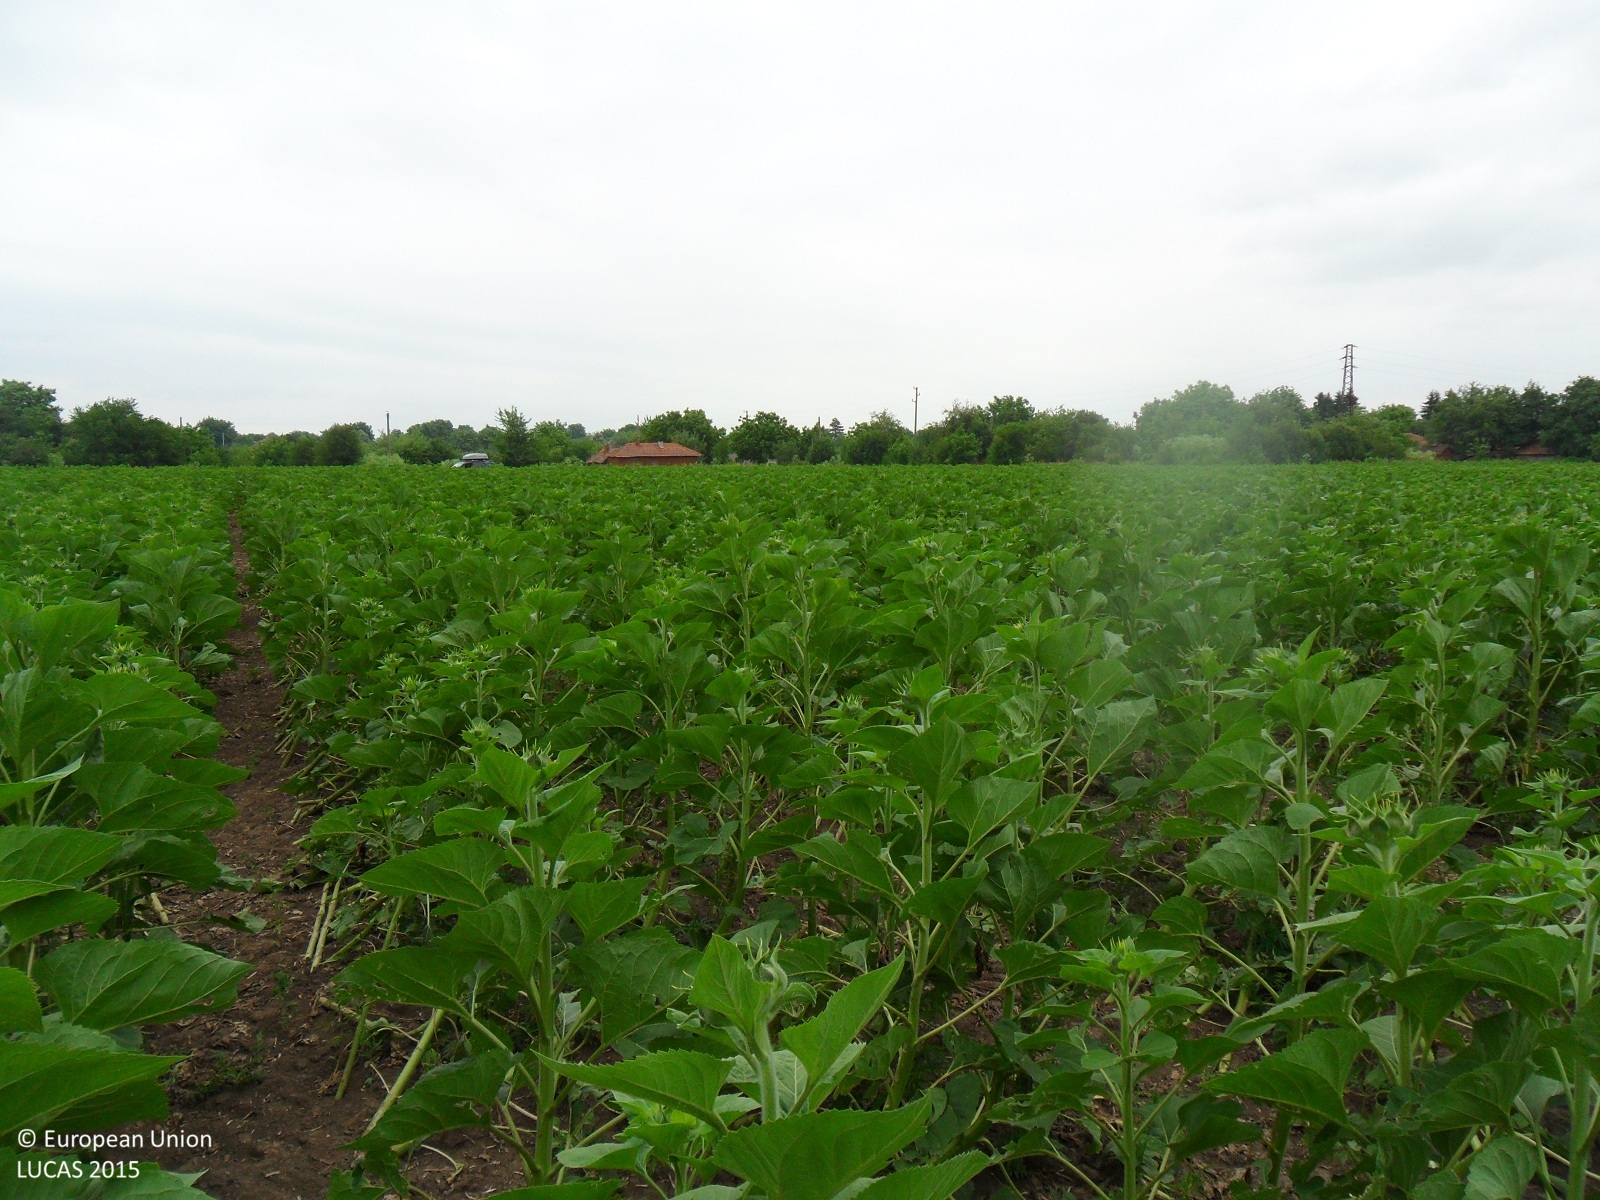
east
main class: Cropland
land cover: Sunflower
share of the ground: > 75 %
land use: Agriculture (excluding fallow land and kitchen gardens)
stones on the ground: < 10 %
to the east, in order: Sunflower; Grass margins; Tracks; Grass margins; Other fresh vegetables; Shrubland without tree cover; Other fresh vegetables; Shruby margins; Electric lines; Grass margins; Paved roads, cycling and walking lanes; Grassland with sparse tree/shrub cover; Fences; Nuts trees; Fences; Broadleaved woodland; Grassland without tree/shrub cover
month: June
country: BG
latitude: 43.8130
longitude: 26.8122
